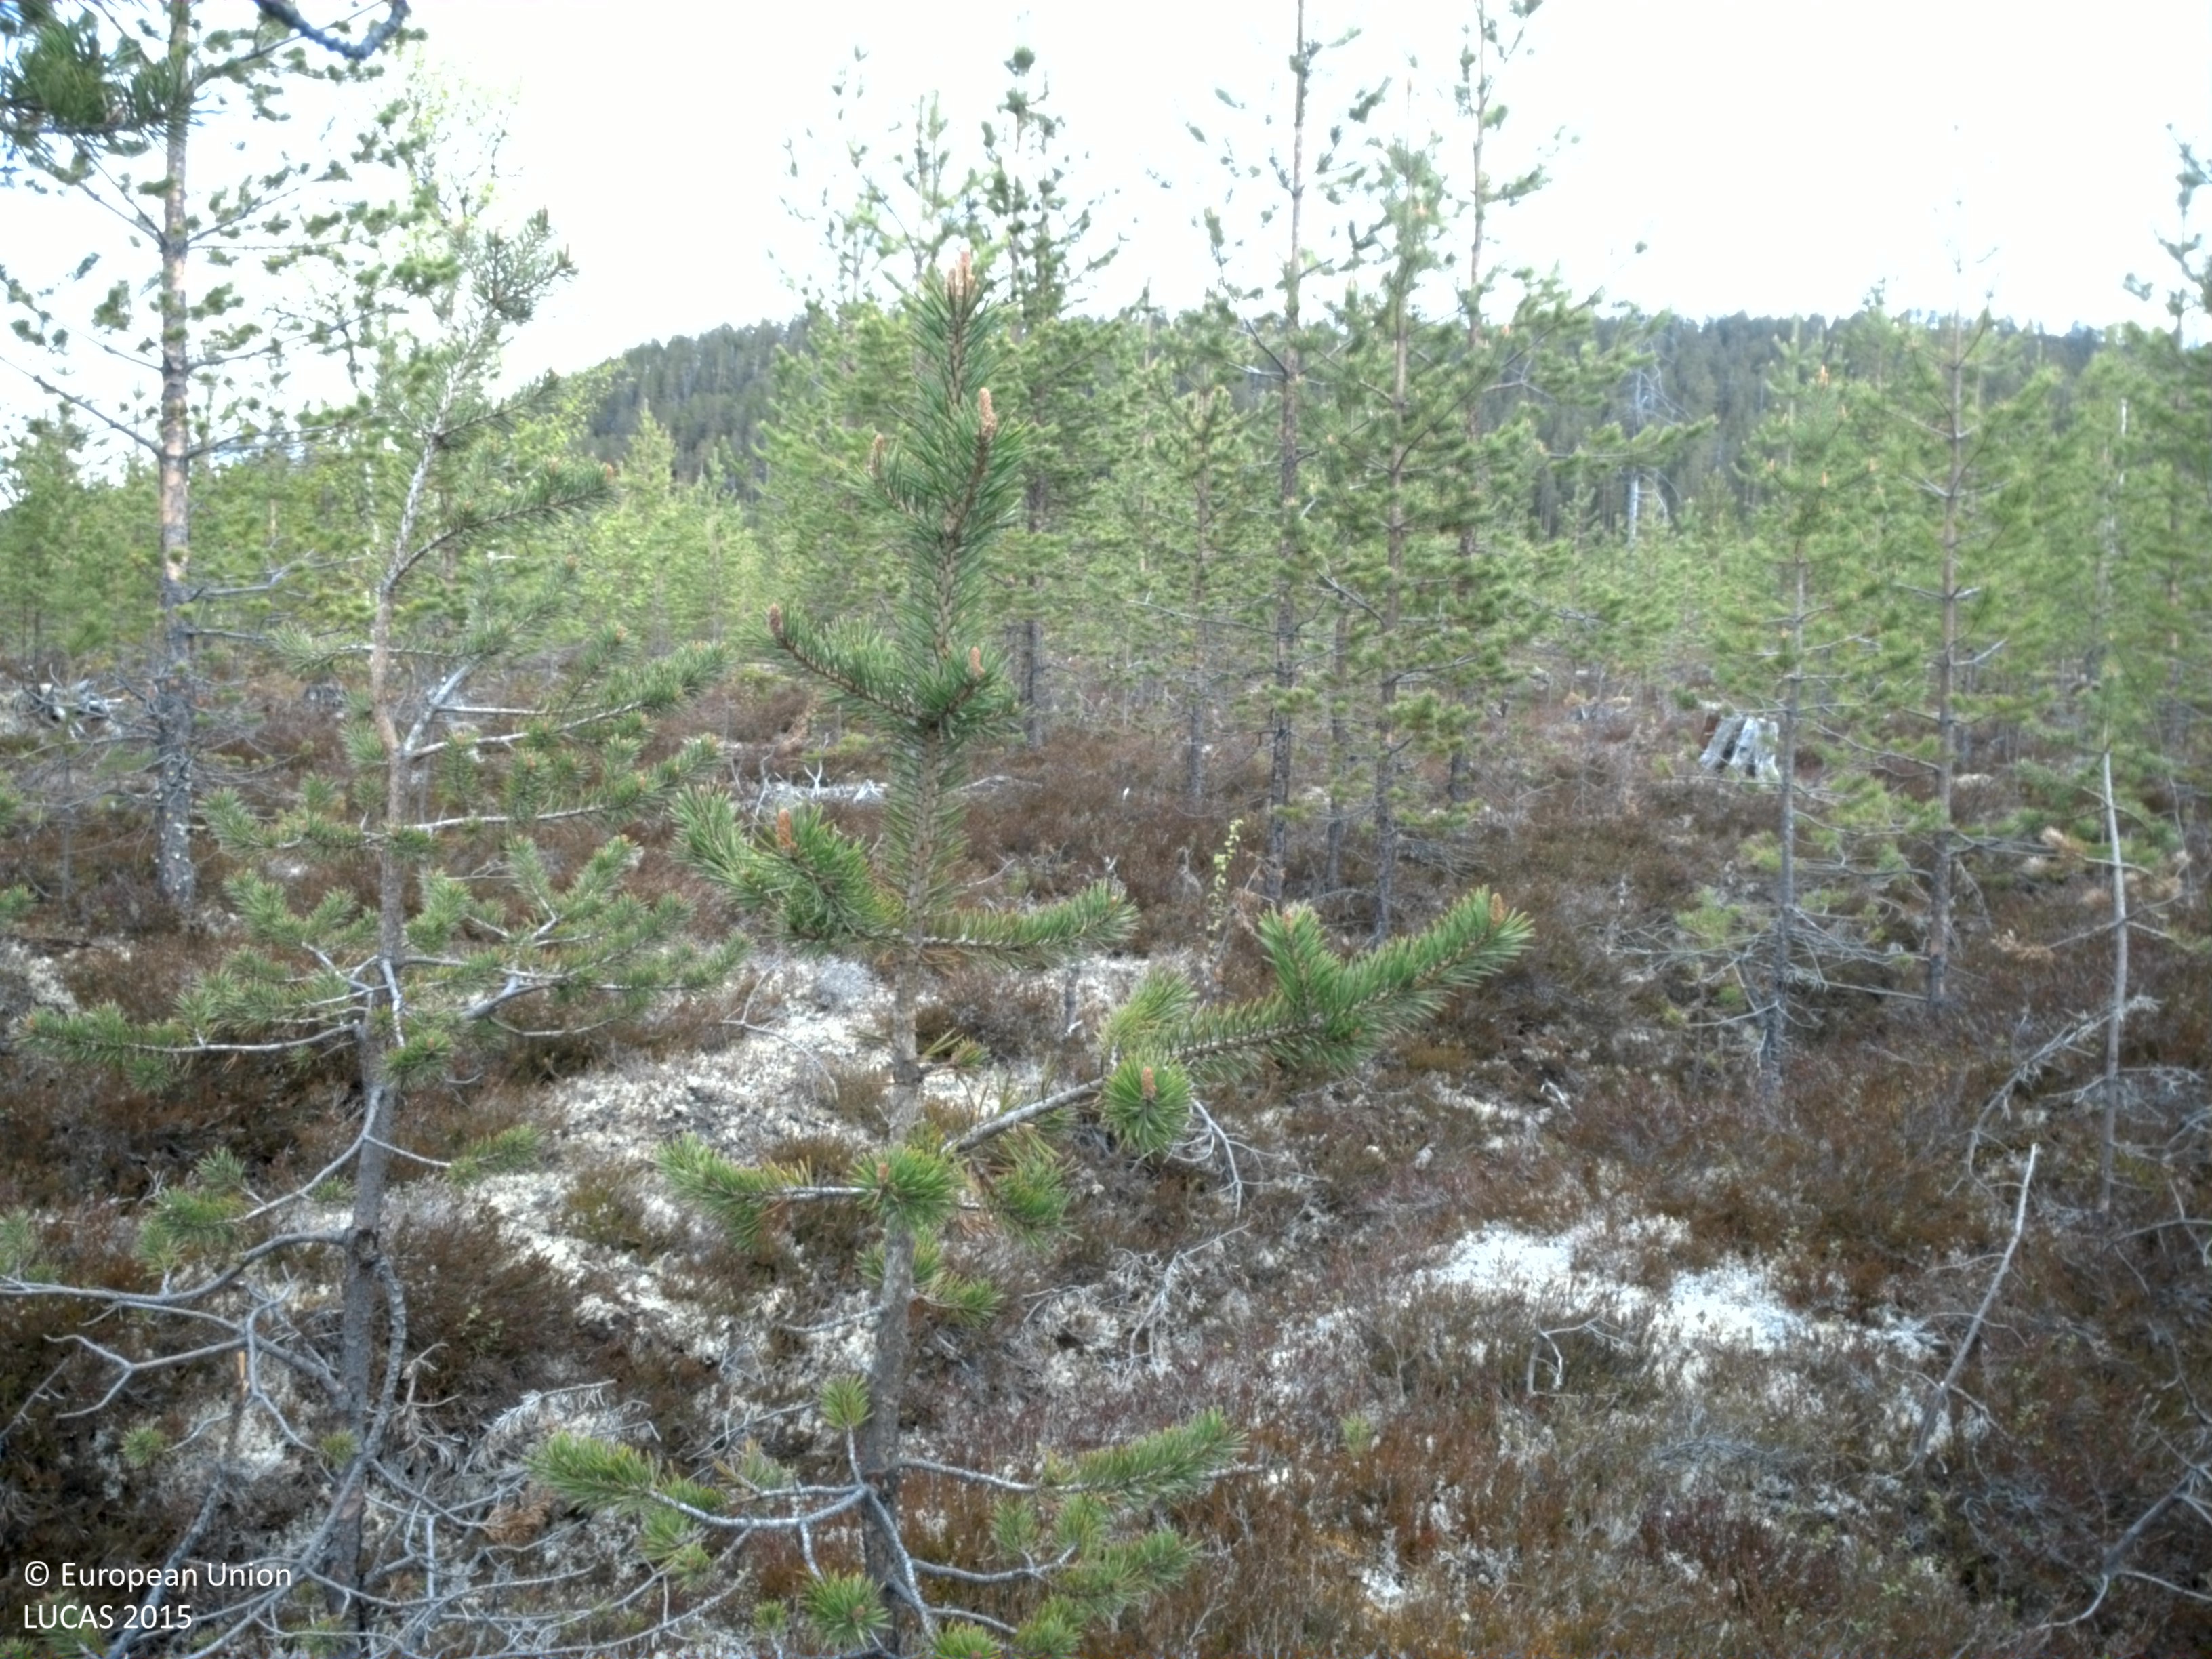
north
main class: Woodland
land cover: Pine dominated coniferous woodland
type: boreal forest
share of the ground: 25 - 50 %
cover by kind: shrubs 55 %, coniferous forest trees 35 %, lichens and mosses 10 %
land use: Forestry
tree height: < 5 m
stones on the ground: < 10 %
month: June
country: SE
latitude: 66.0970
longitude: 19.2230
